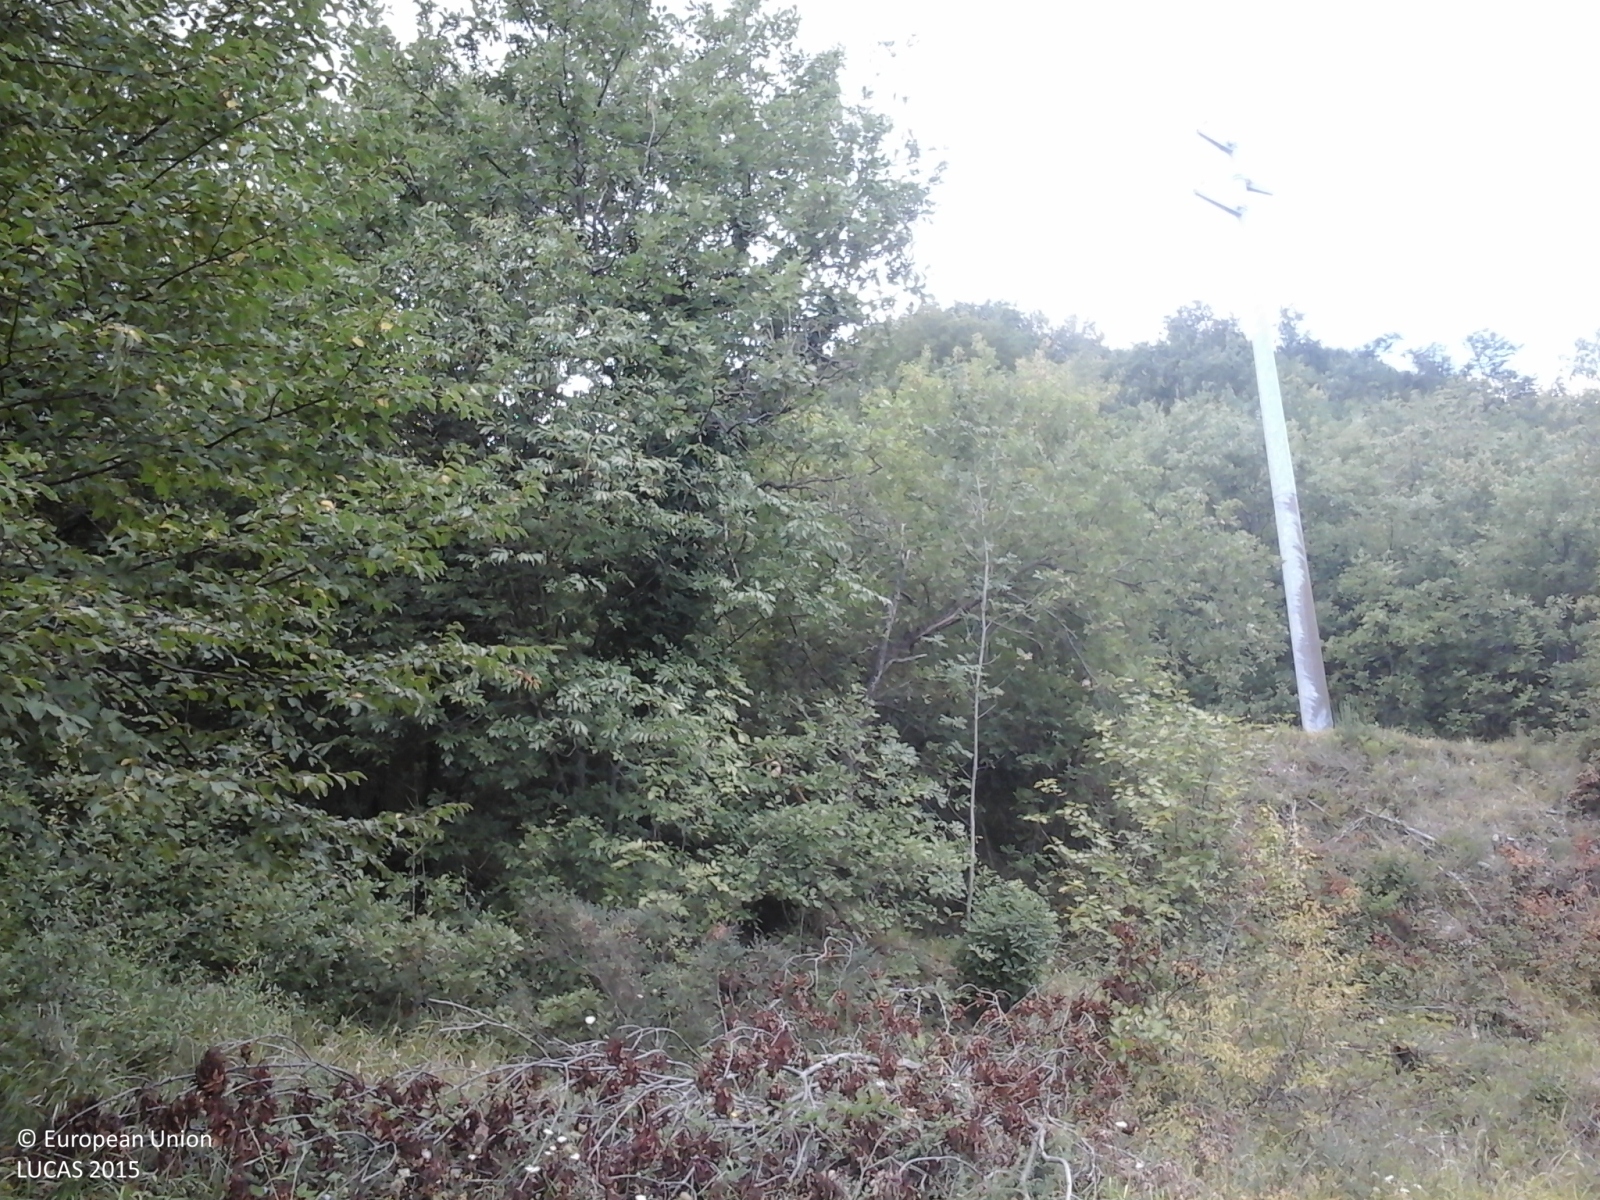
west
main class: Shrubland
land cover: Shrubland with sparse tree cover
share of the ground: > 75 %
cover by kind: herbaceous plants 55 %, shrubs 40 %, broadleaved forest trees 5 %
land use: Agriculture (excluding fallow land and kitchen gardens)
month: August
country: IT
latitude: 43.1839
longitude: 13.1289
